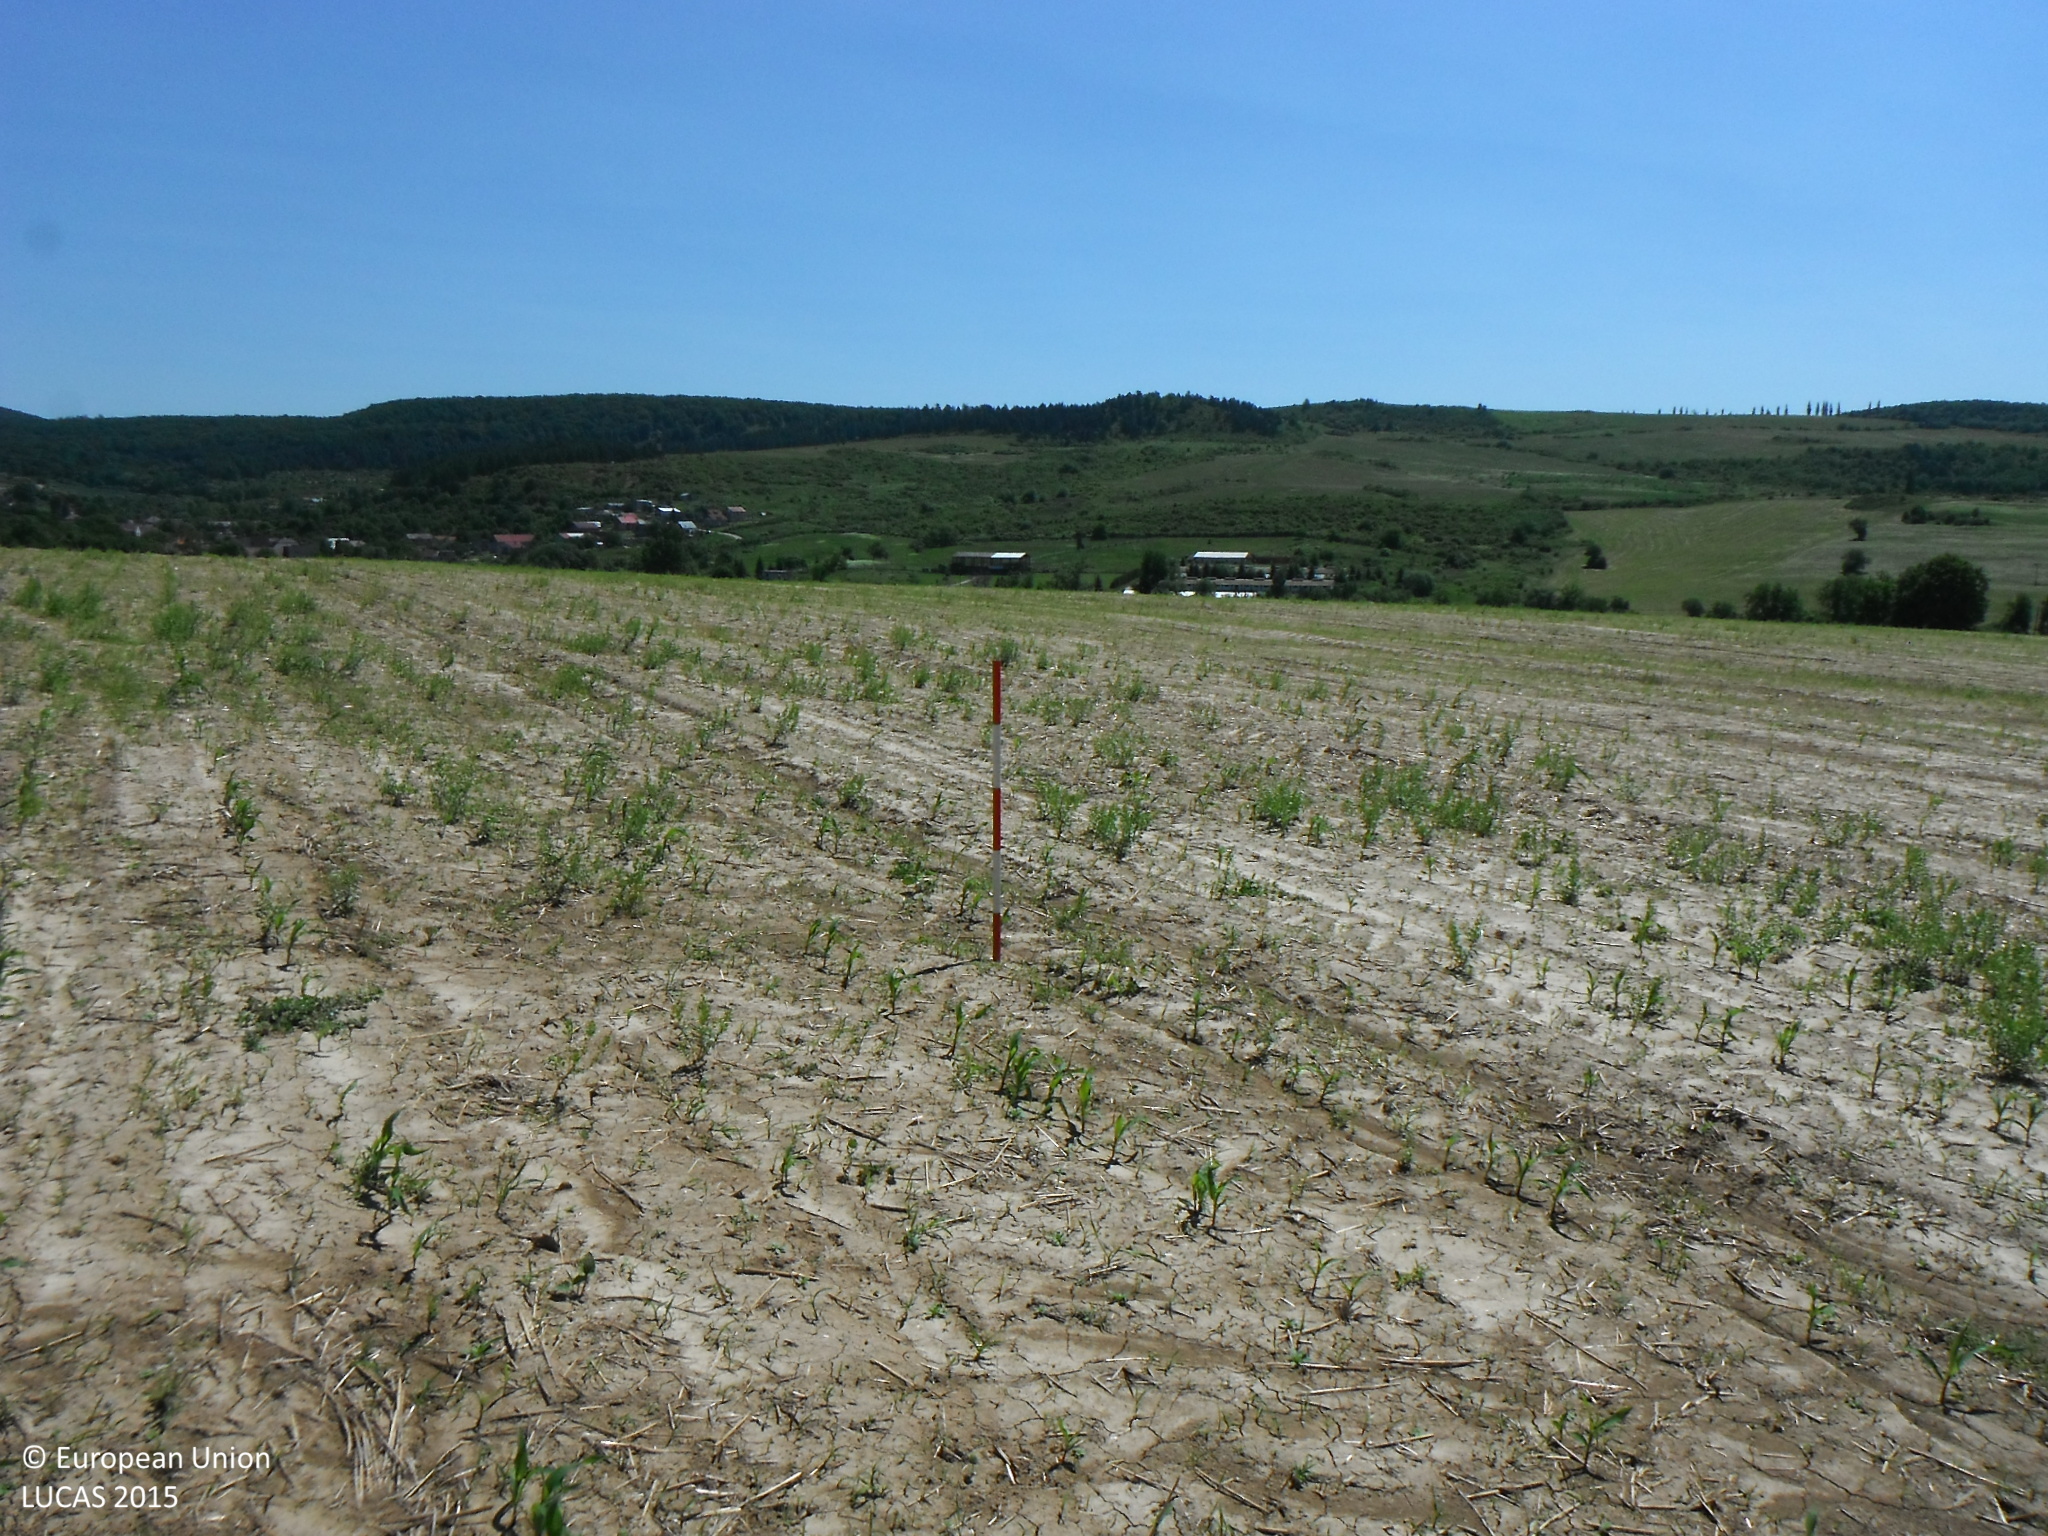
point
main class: Cropland
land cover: Maize
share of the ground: < 10 %
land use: Agriculture (excluding fallow land and kitchen gardens)
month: June
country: SK
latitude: 48.8531
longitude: 21.3442
